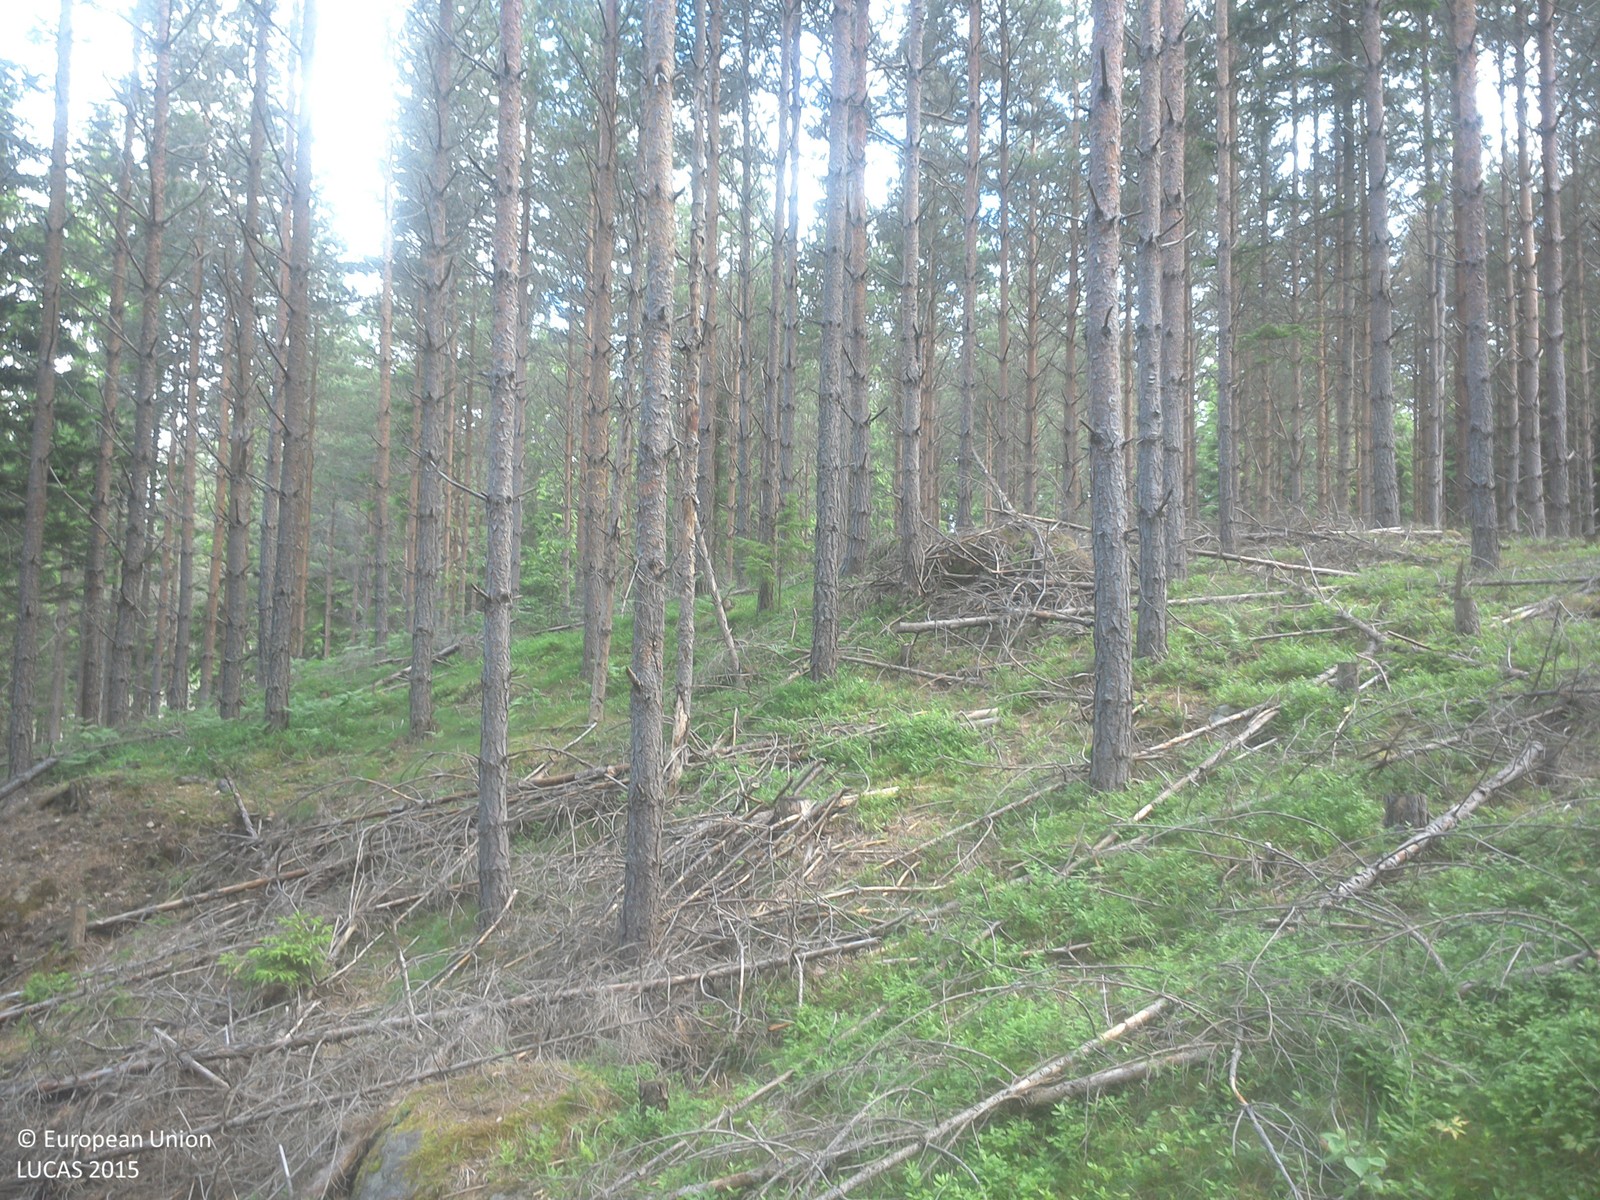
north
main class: Woodland
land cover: Pine dominated coniferous woodland
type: boreal forest
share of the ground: 50 - 75 %
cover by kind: coniferous forest trees 55 %, lichens and mosses 25 %, herbaceous plants 20 %
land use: Forestry
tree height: > 5 m
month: June
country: SE
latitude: 58.1877
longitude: 15.7272
